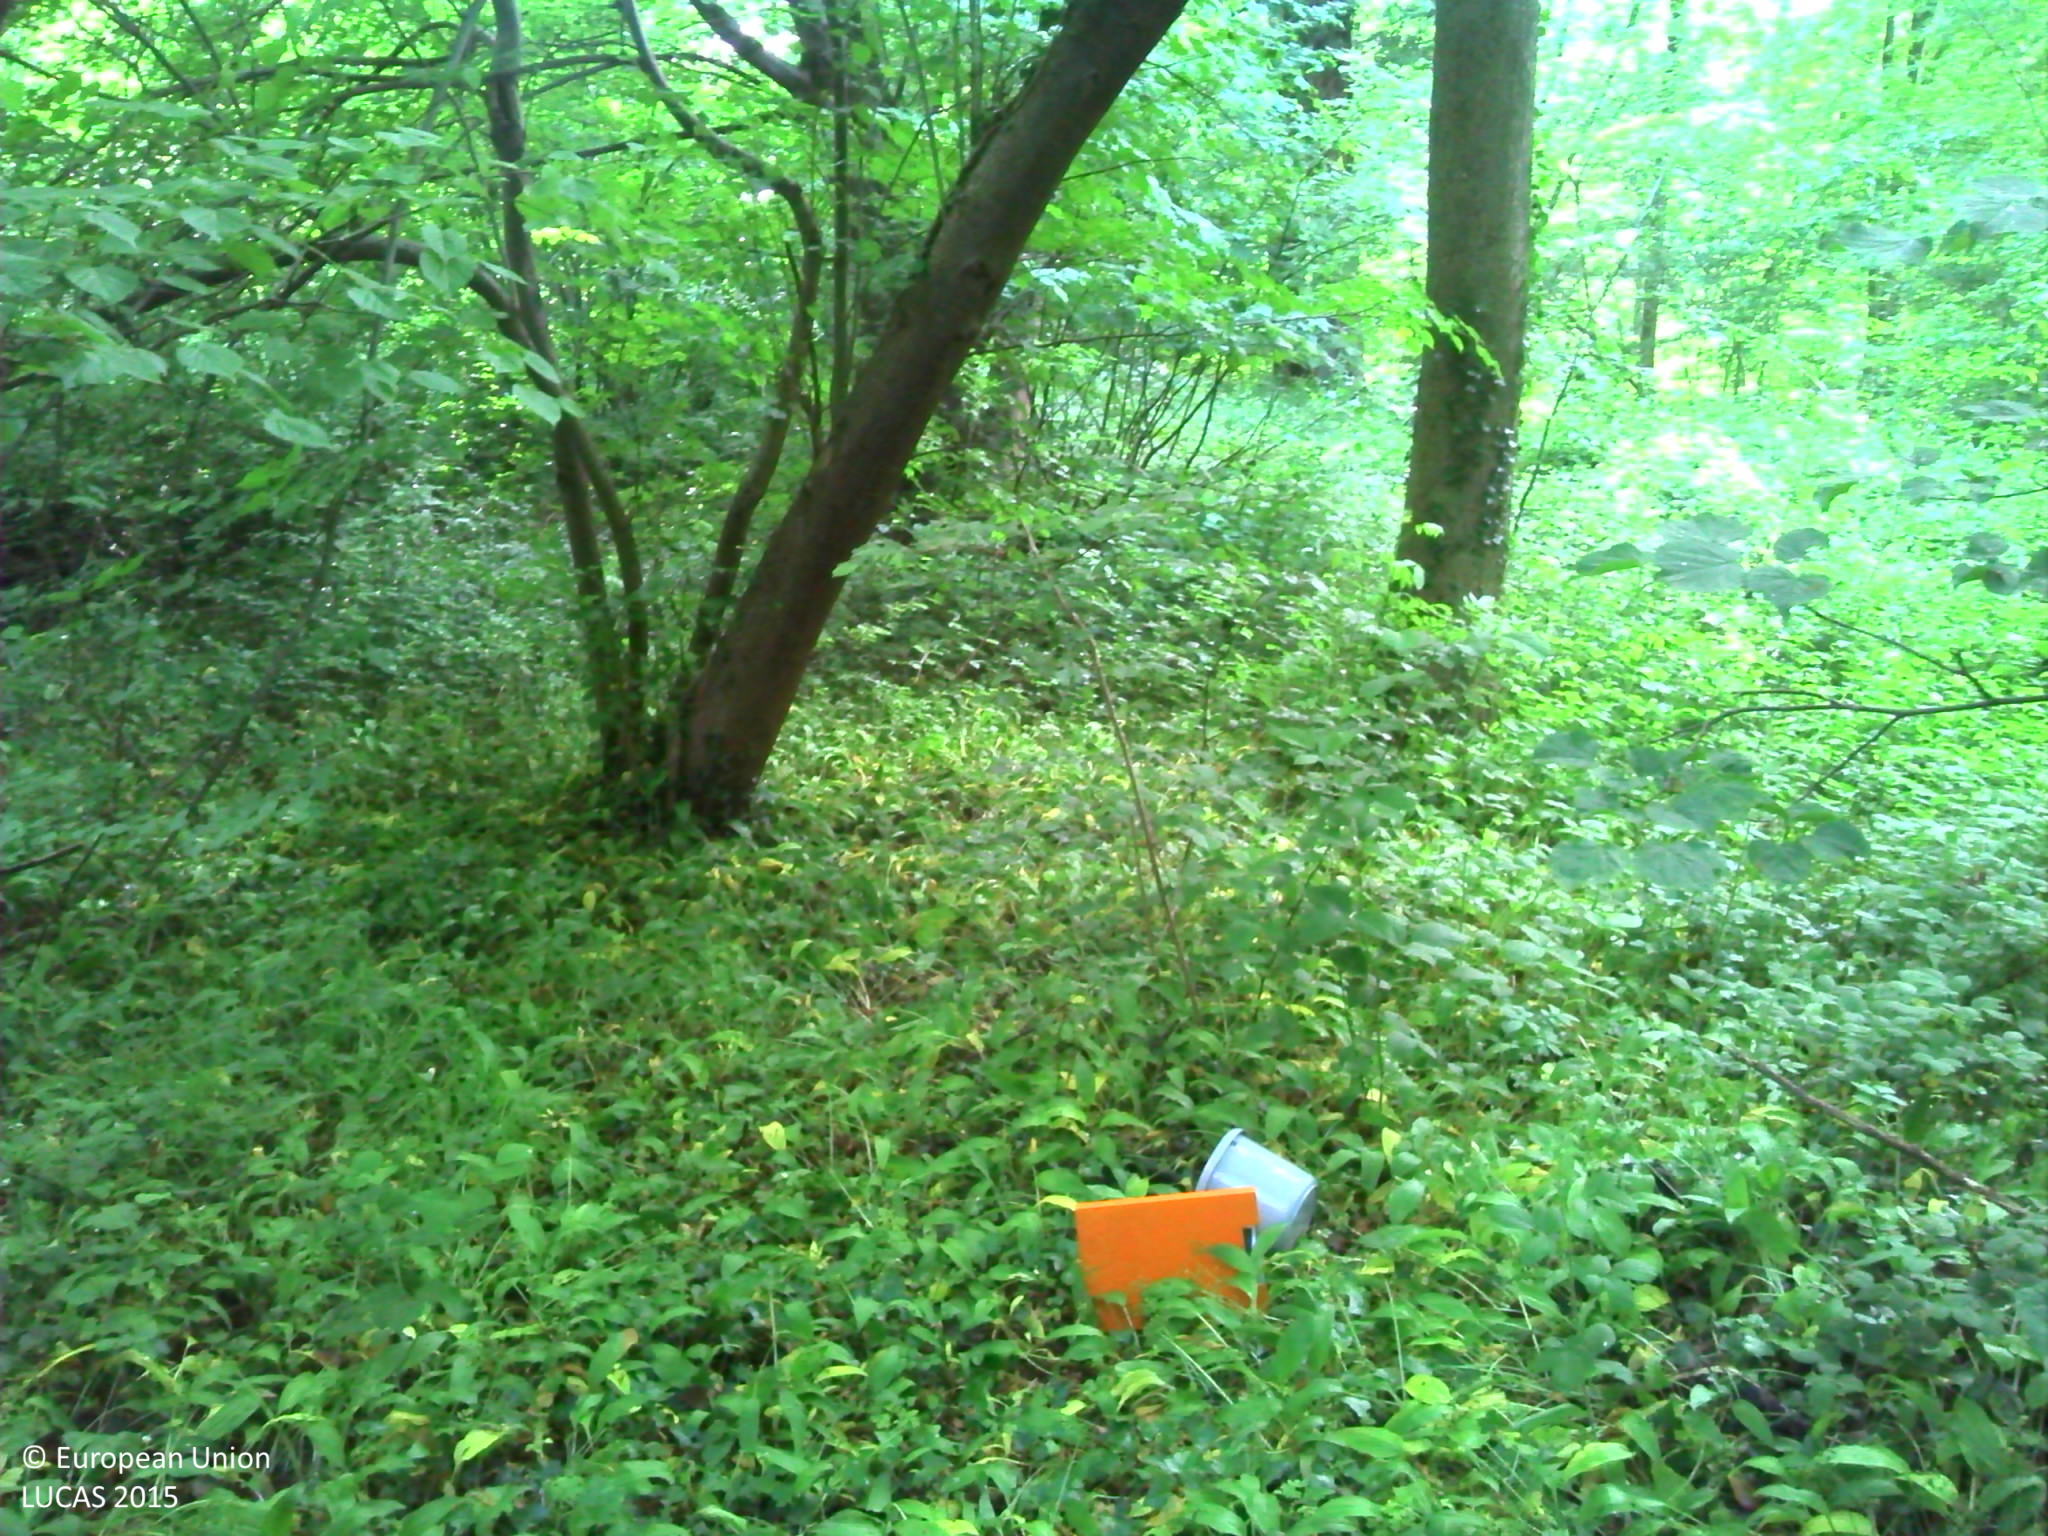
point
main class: Woodland
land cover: Broadleaved woodland
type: beech forest
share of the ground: > 75 %
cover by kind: broadleaved forest trees 100 %
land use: Forestry
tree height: > 5 m
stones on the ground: < 10 %
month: June
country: FR
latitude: 49.5533
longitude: 3.2877
